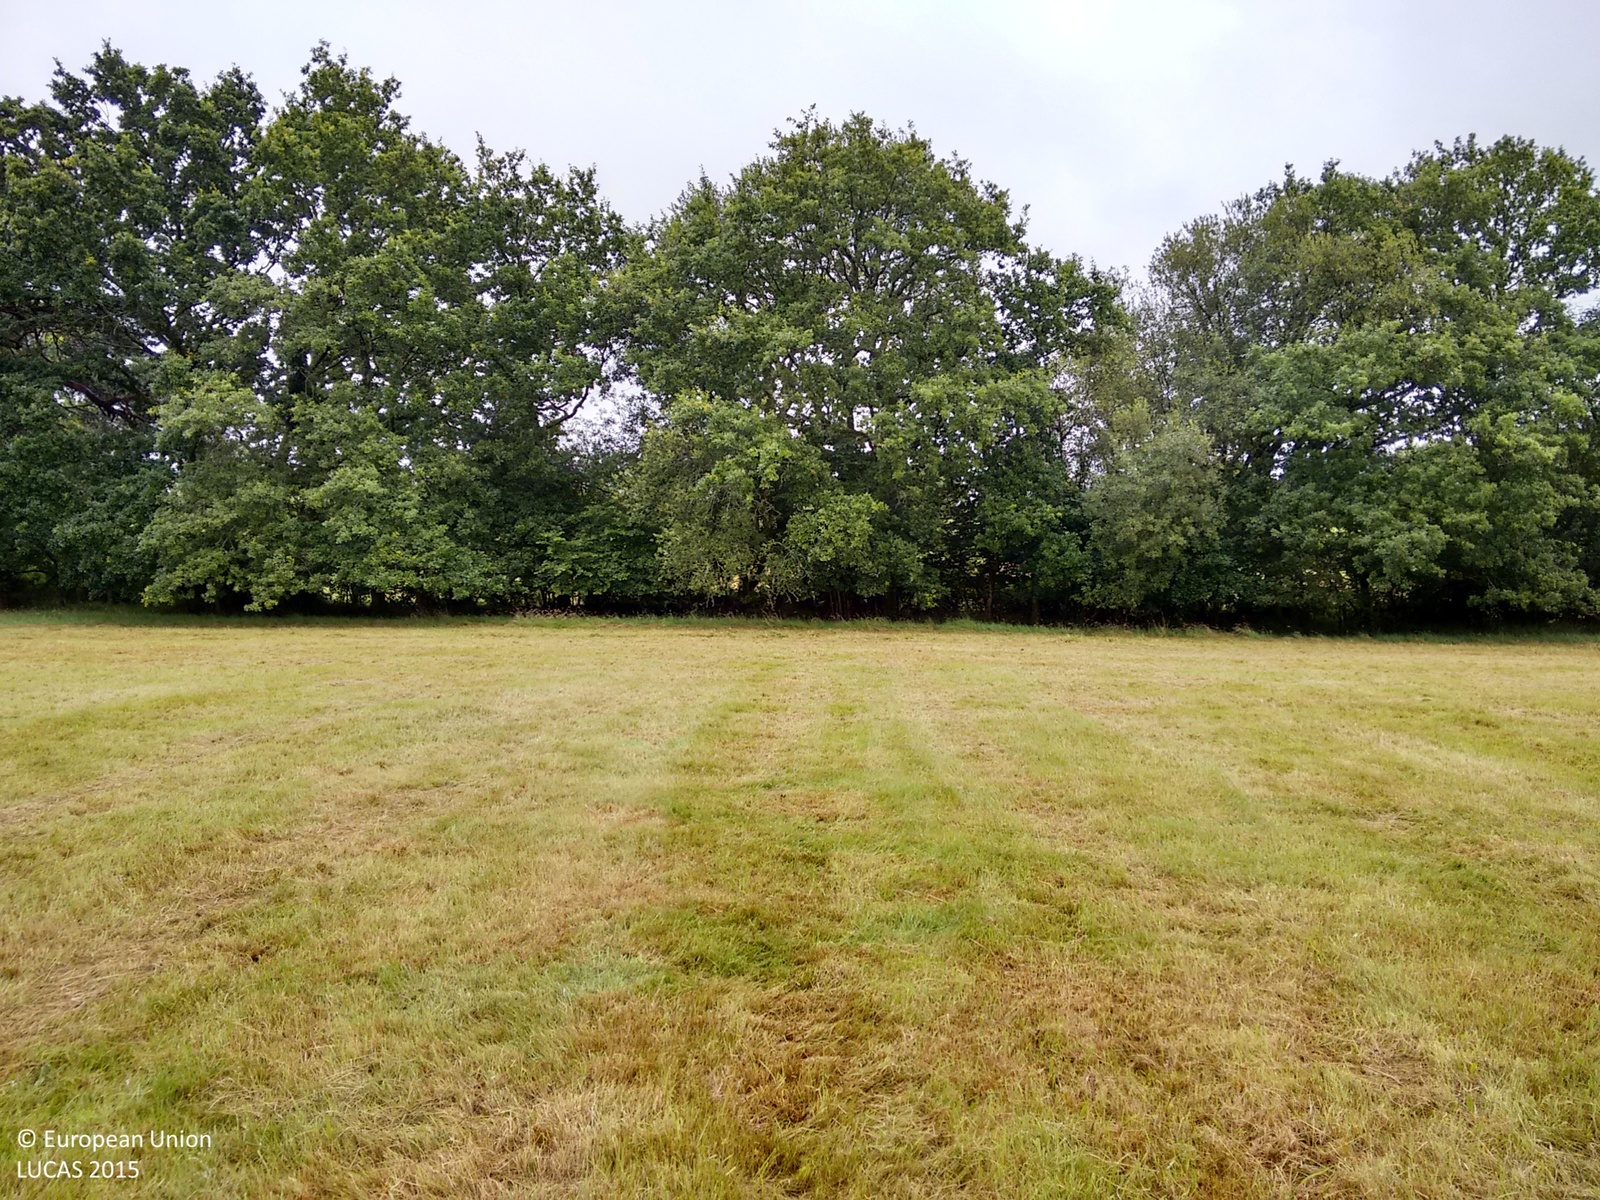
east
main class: Grassland
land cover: Grassland without tree/shrub cover
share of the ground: > 75 %
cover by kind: herbaceous plants 100 %
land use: Agriculture (excluding fallow land and kitchen gardens)
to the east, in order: Grassland without tree/shrub cover; Grass margins; Abandoned hedges; Fences; Rivers and streams; Abandoned hedges; Fences; Grass margins; Grassland without tree/shrub cover; Fences; Abandoned hedges; Rivers and streams; Fences; Grassland without tree/shrub cover; Fences; Shruby margins; Ditches and canals; Abandoned hedges; Fences; Shruby margins; Grassland without tree/shrub cover
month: August
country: GB
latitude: 51.9034
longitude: -4.0339
